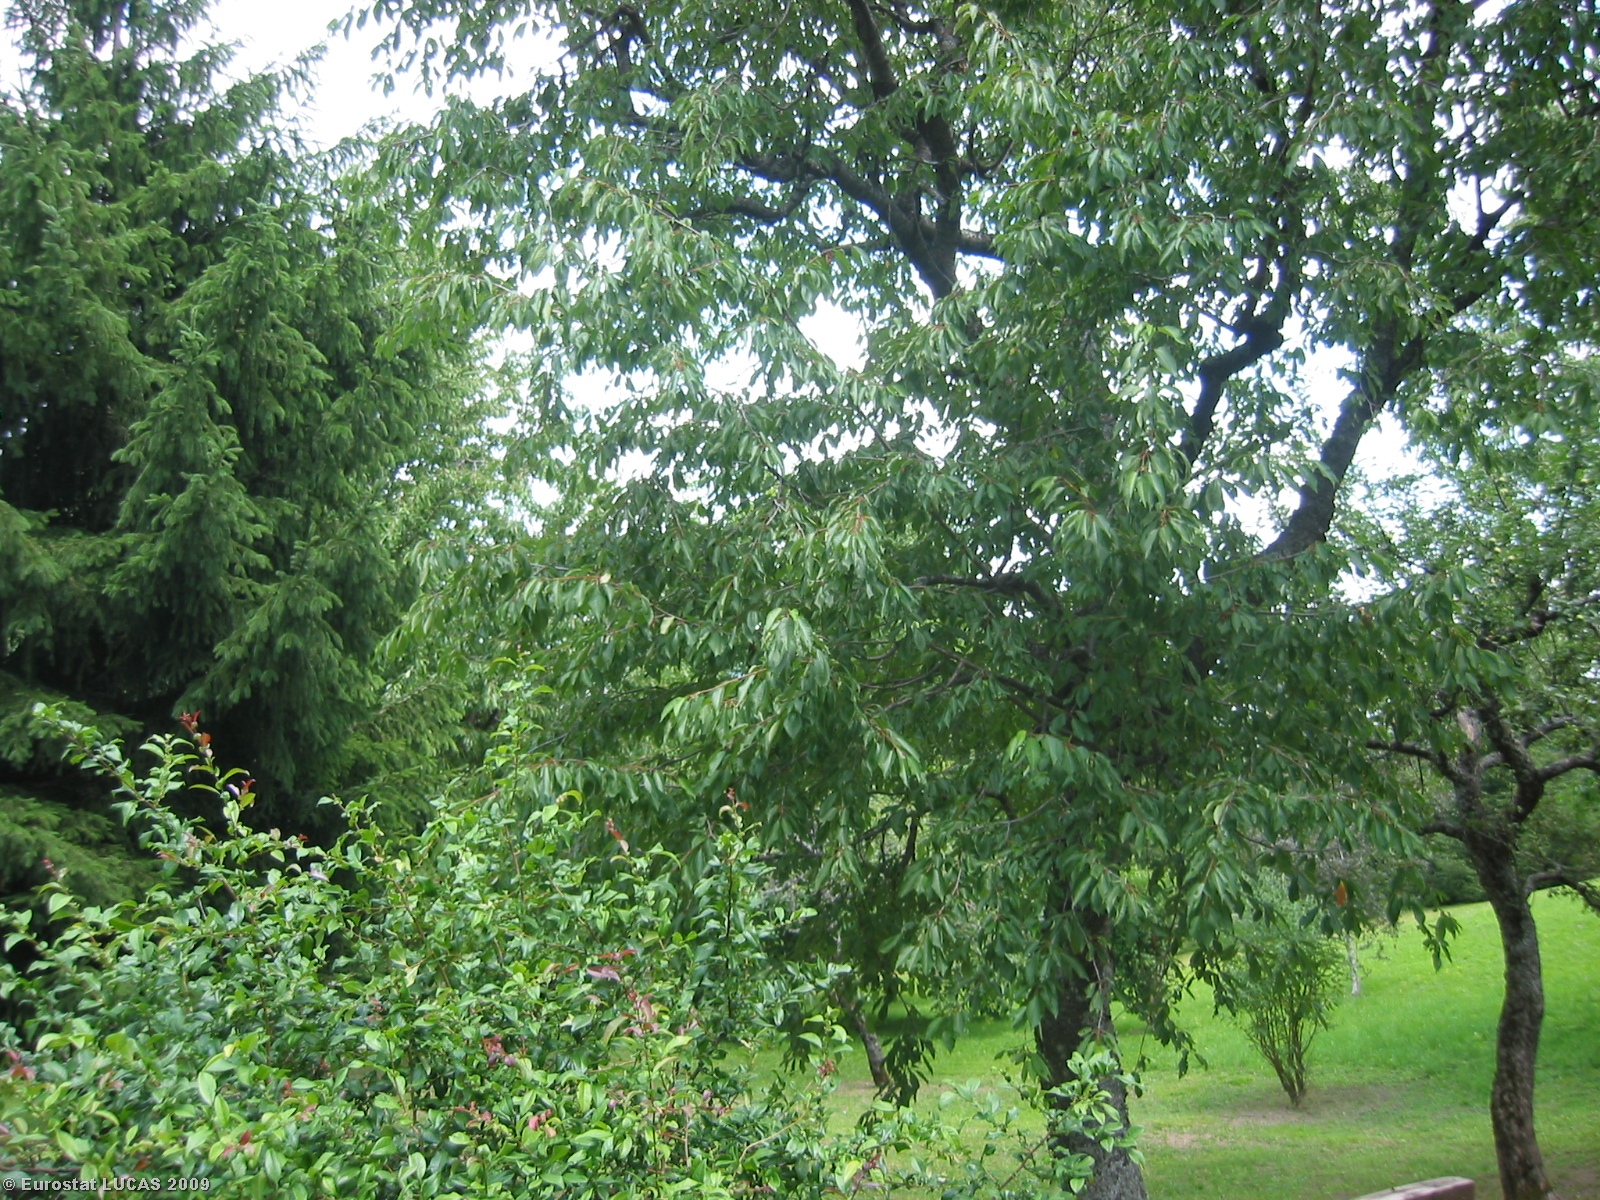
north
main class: Grassland
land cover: Grassland with sparse tree/shrub cover
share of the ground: > 75 %
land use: Residential
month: July
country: IT
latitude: 44.2031
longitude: 10.8115
